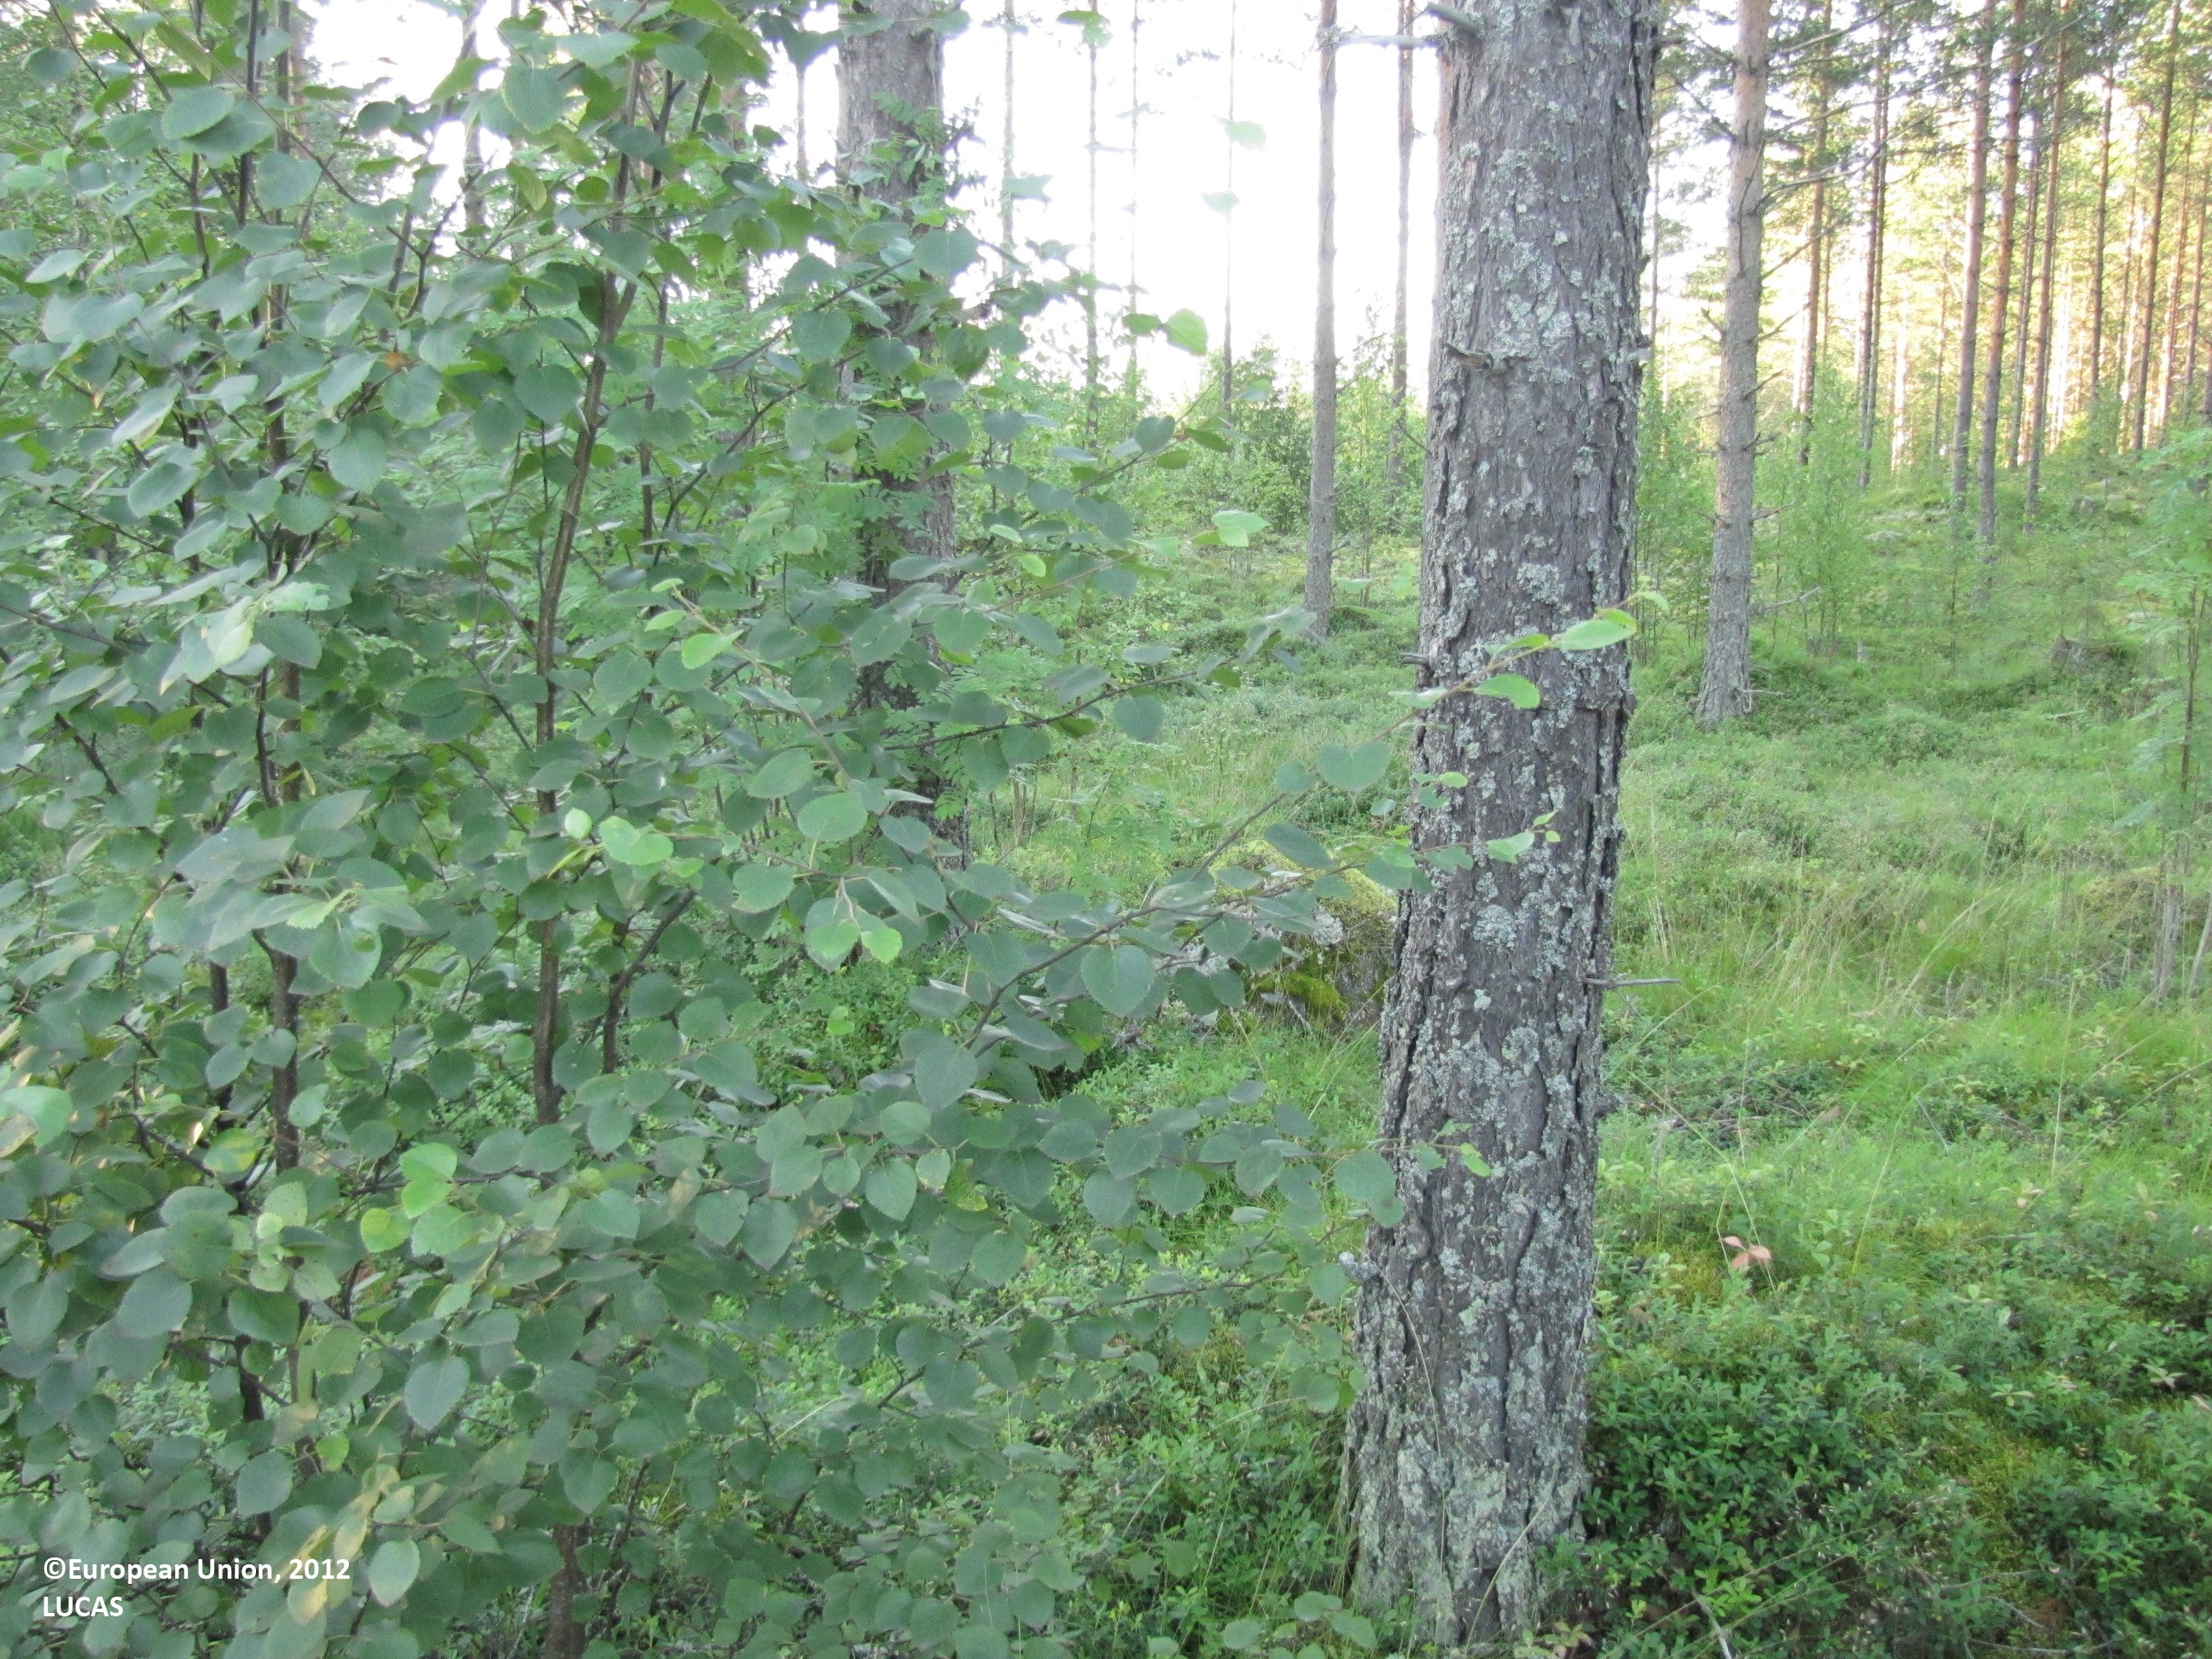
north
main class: Woodland
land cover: Pine dominated coniferous woodland
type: boreal forest
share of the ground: 50 - 75 %
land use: Forestry
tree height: > 5 m
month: July
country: FI
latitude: 62.0800
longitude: 23.0274
